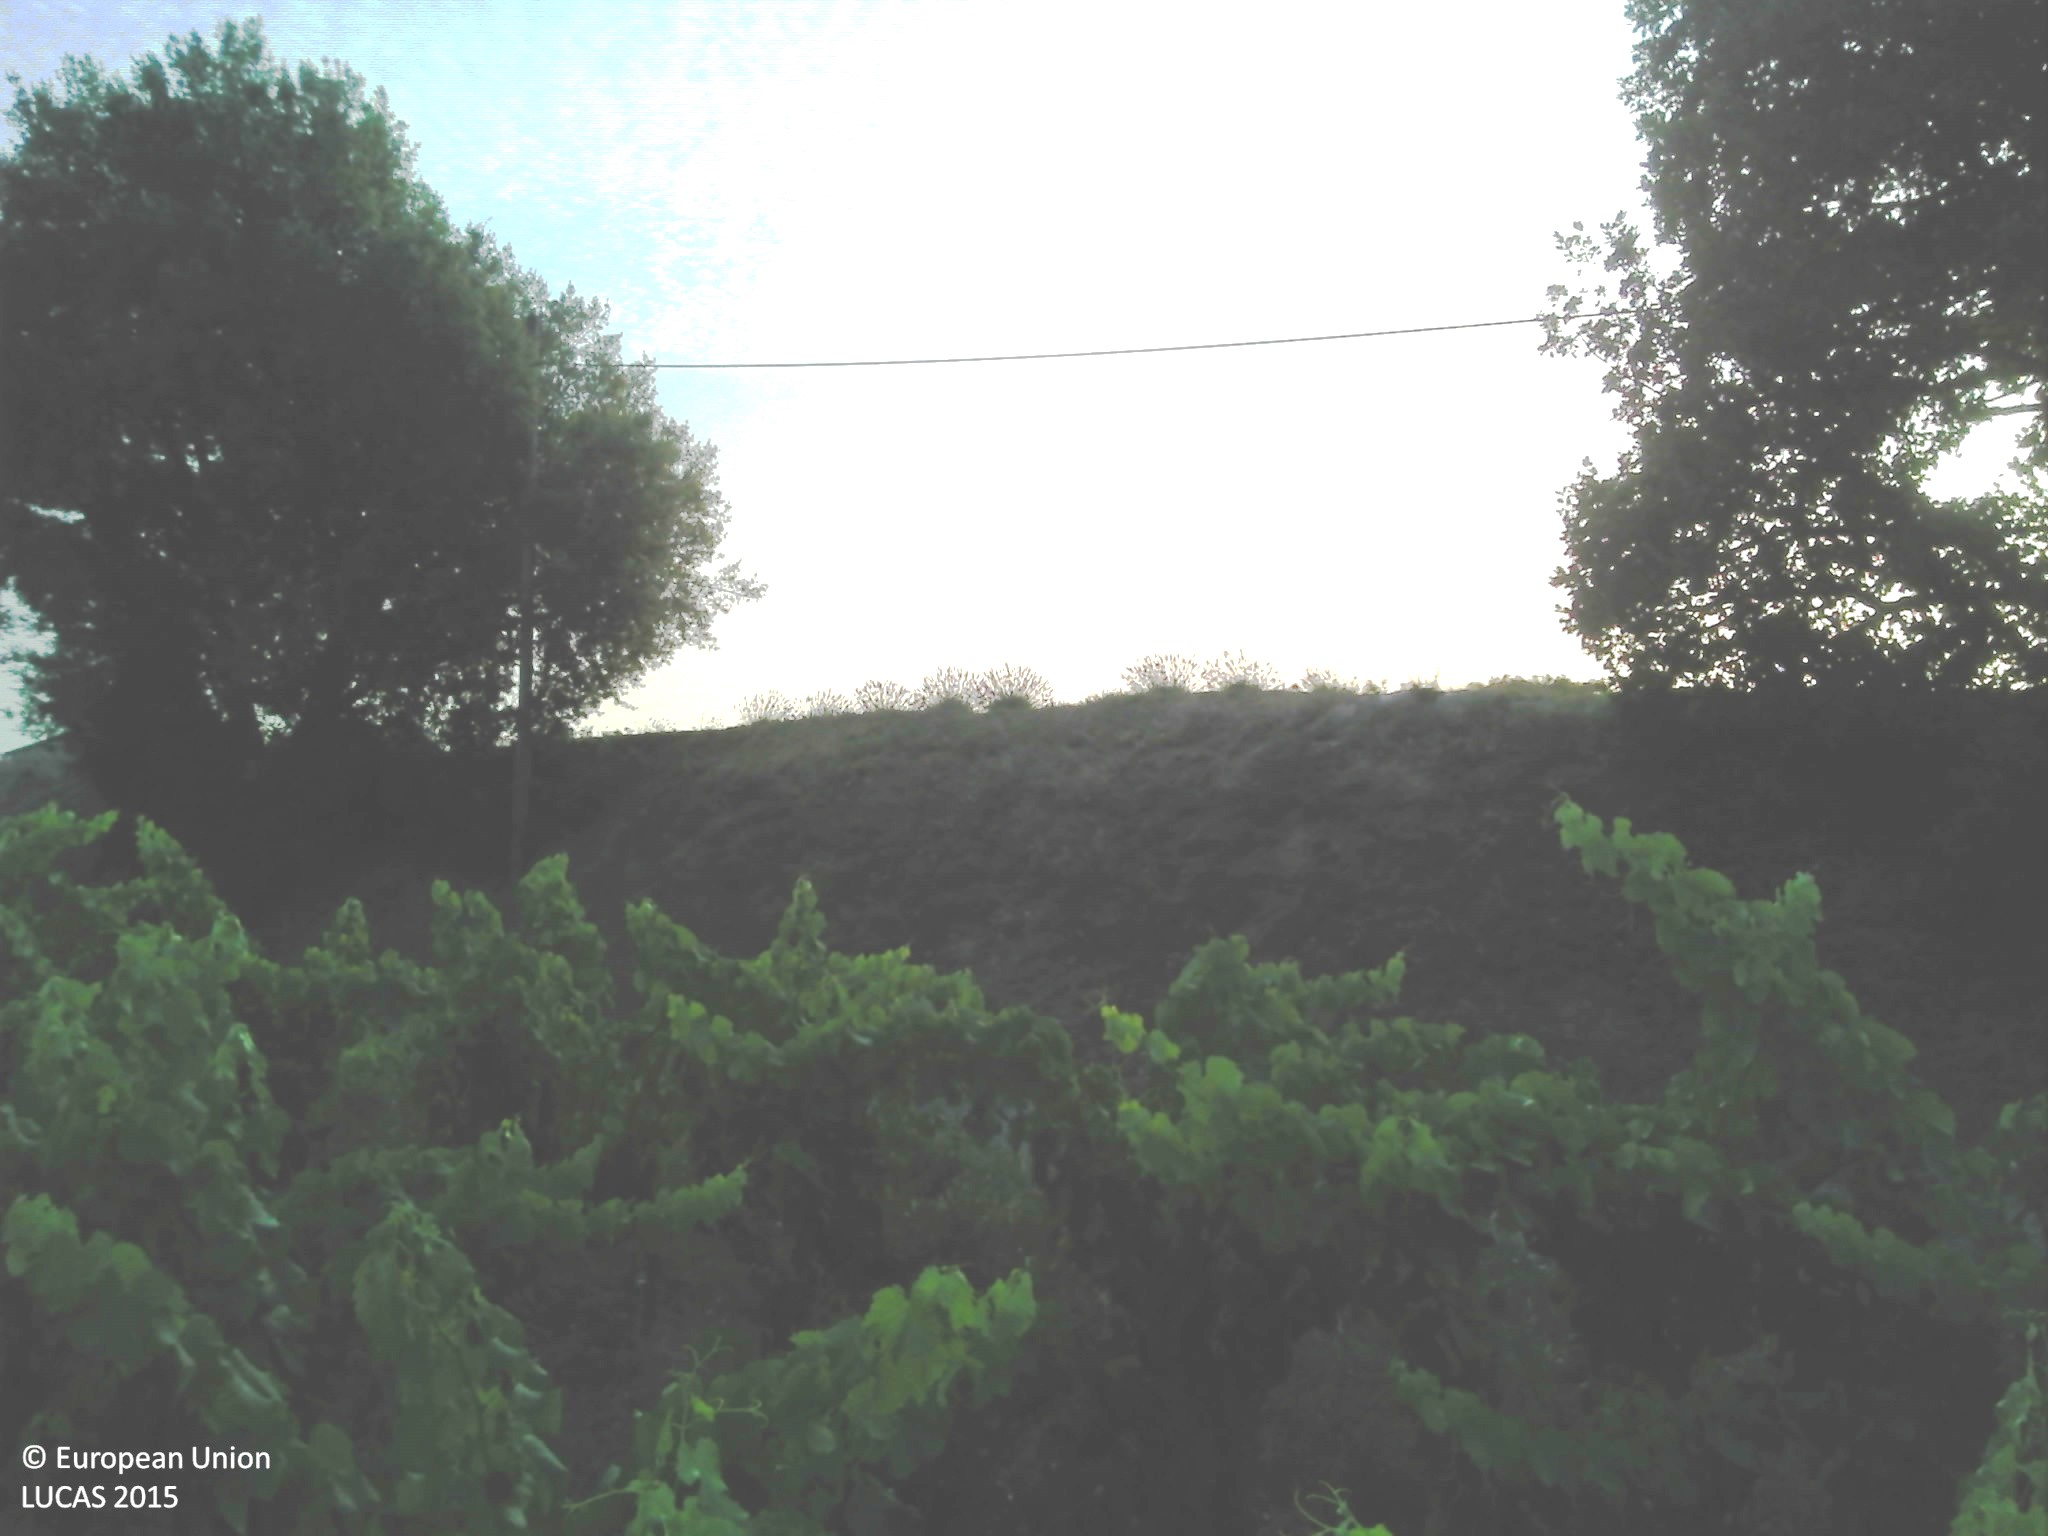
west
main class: Cropland
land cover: Vineyards
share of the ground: > 75 %
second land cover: Spontaneously vegetated surfaces
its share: > 75 %
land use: Agriculture (excluding fallow land and kitchen gardens)
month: July
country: FR
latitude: 44.2522
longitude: 5.0857
